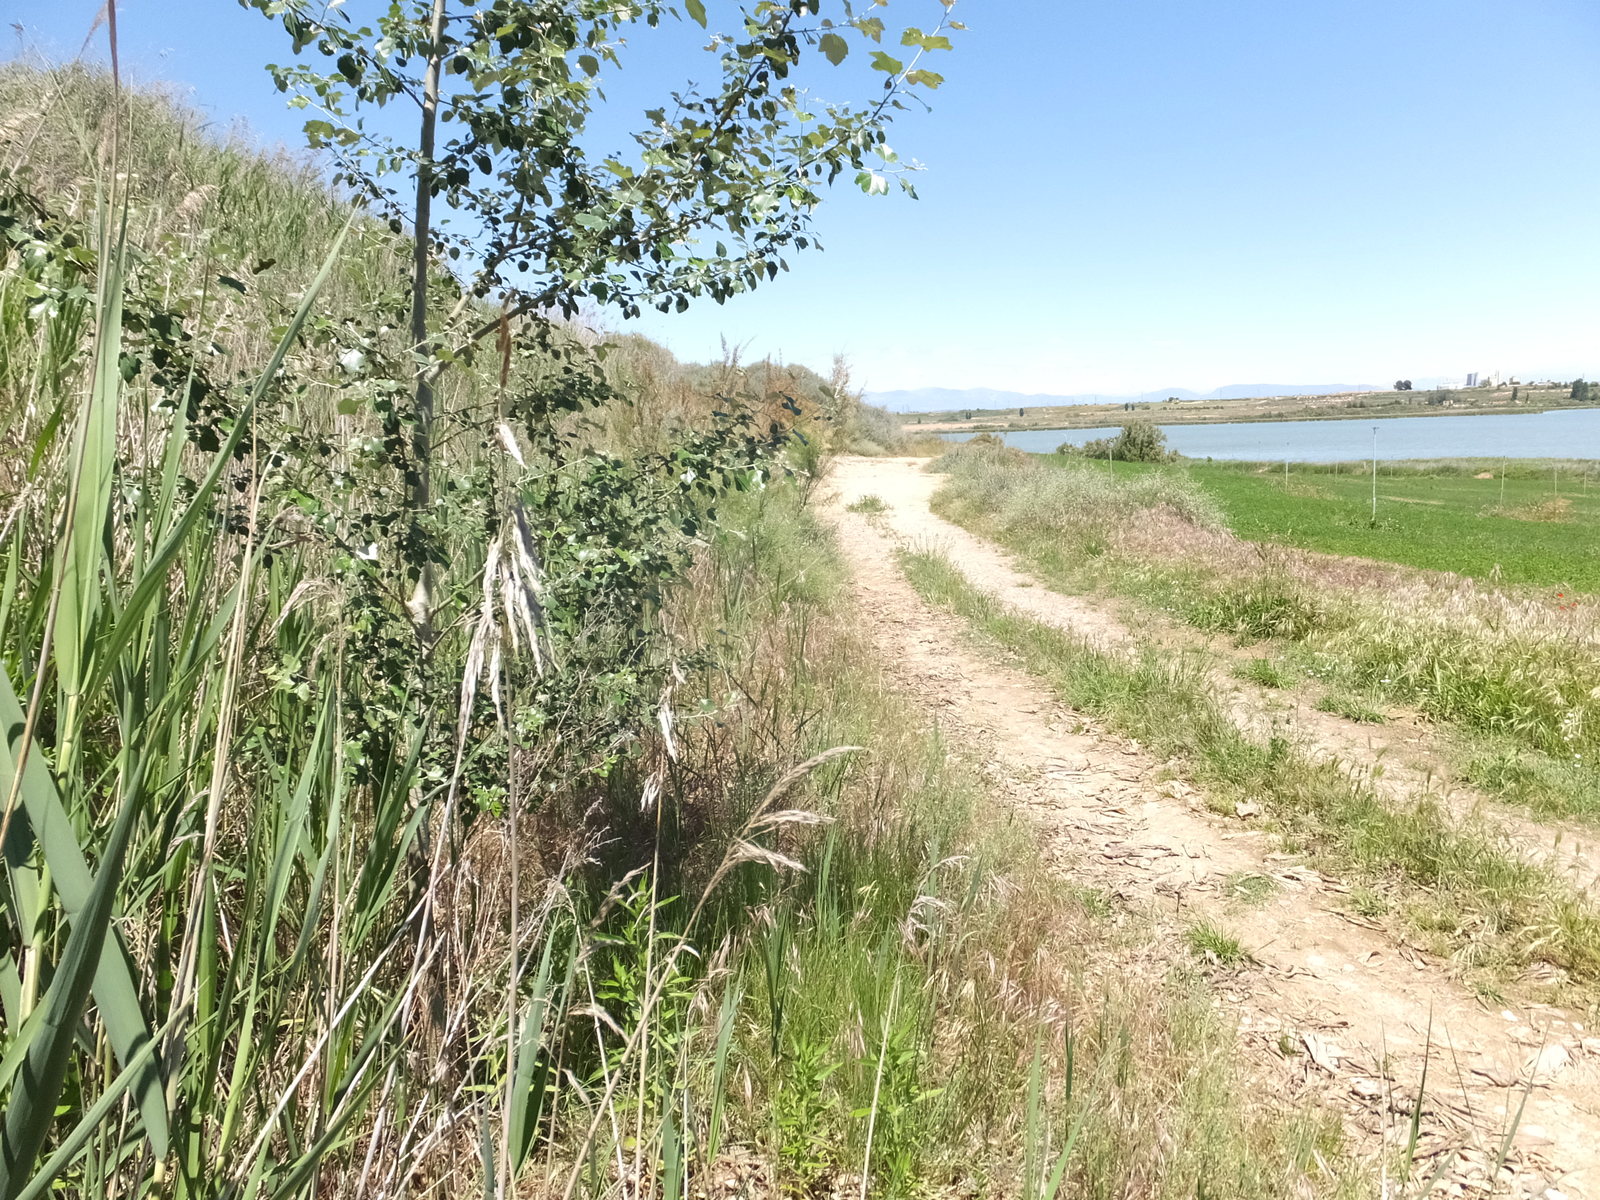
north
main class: Shrubland
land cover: Shrubland without tree cover
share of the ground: > 75 %
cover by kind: herbaceous plants 70 %, shrubs 30 %
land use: Semi-natural and natural areas not in use
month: May
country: ES
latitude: 41.7935
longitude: -0.1869
